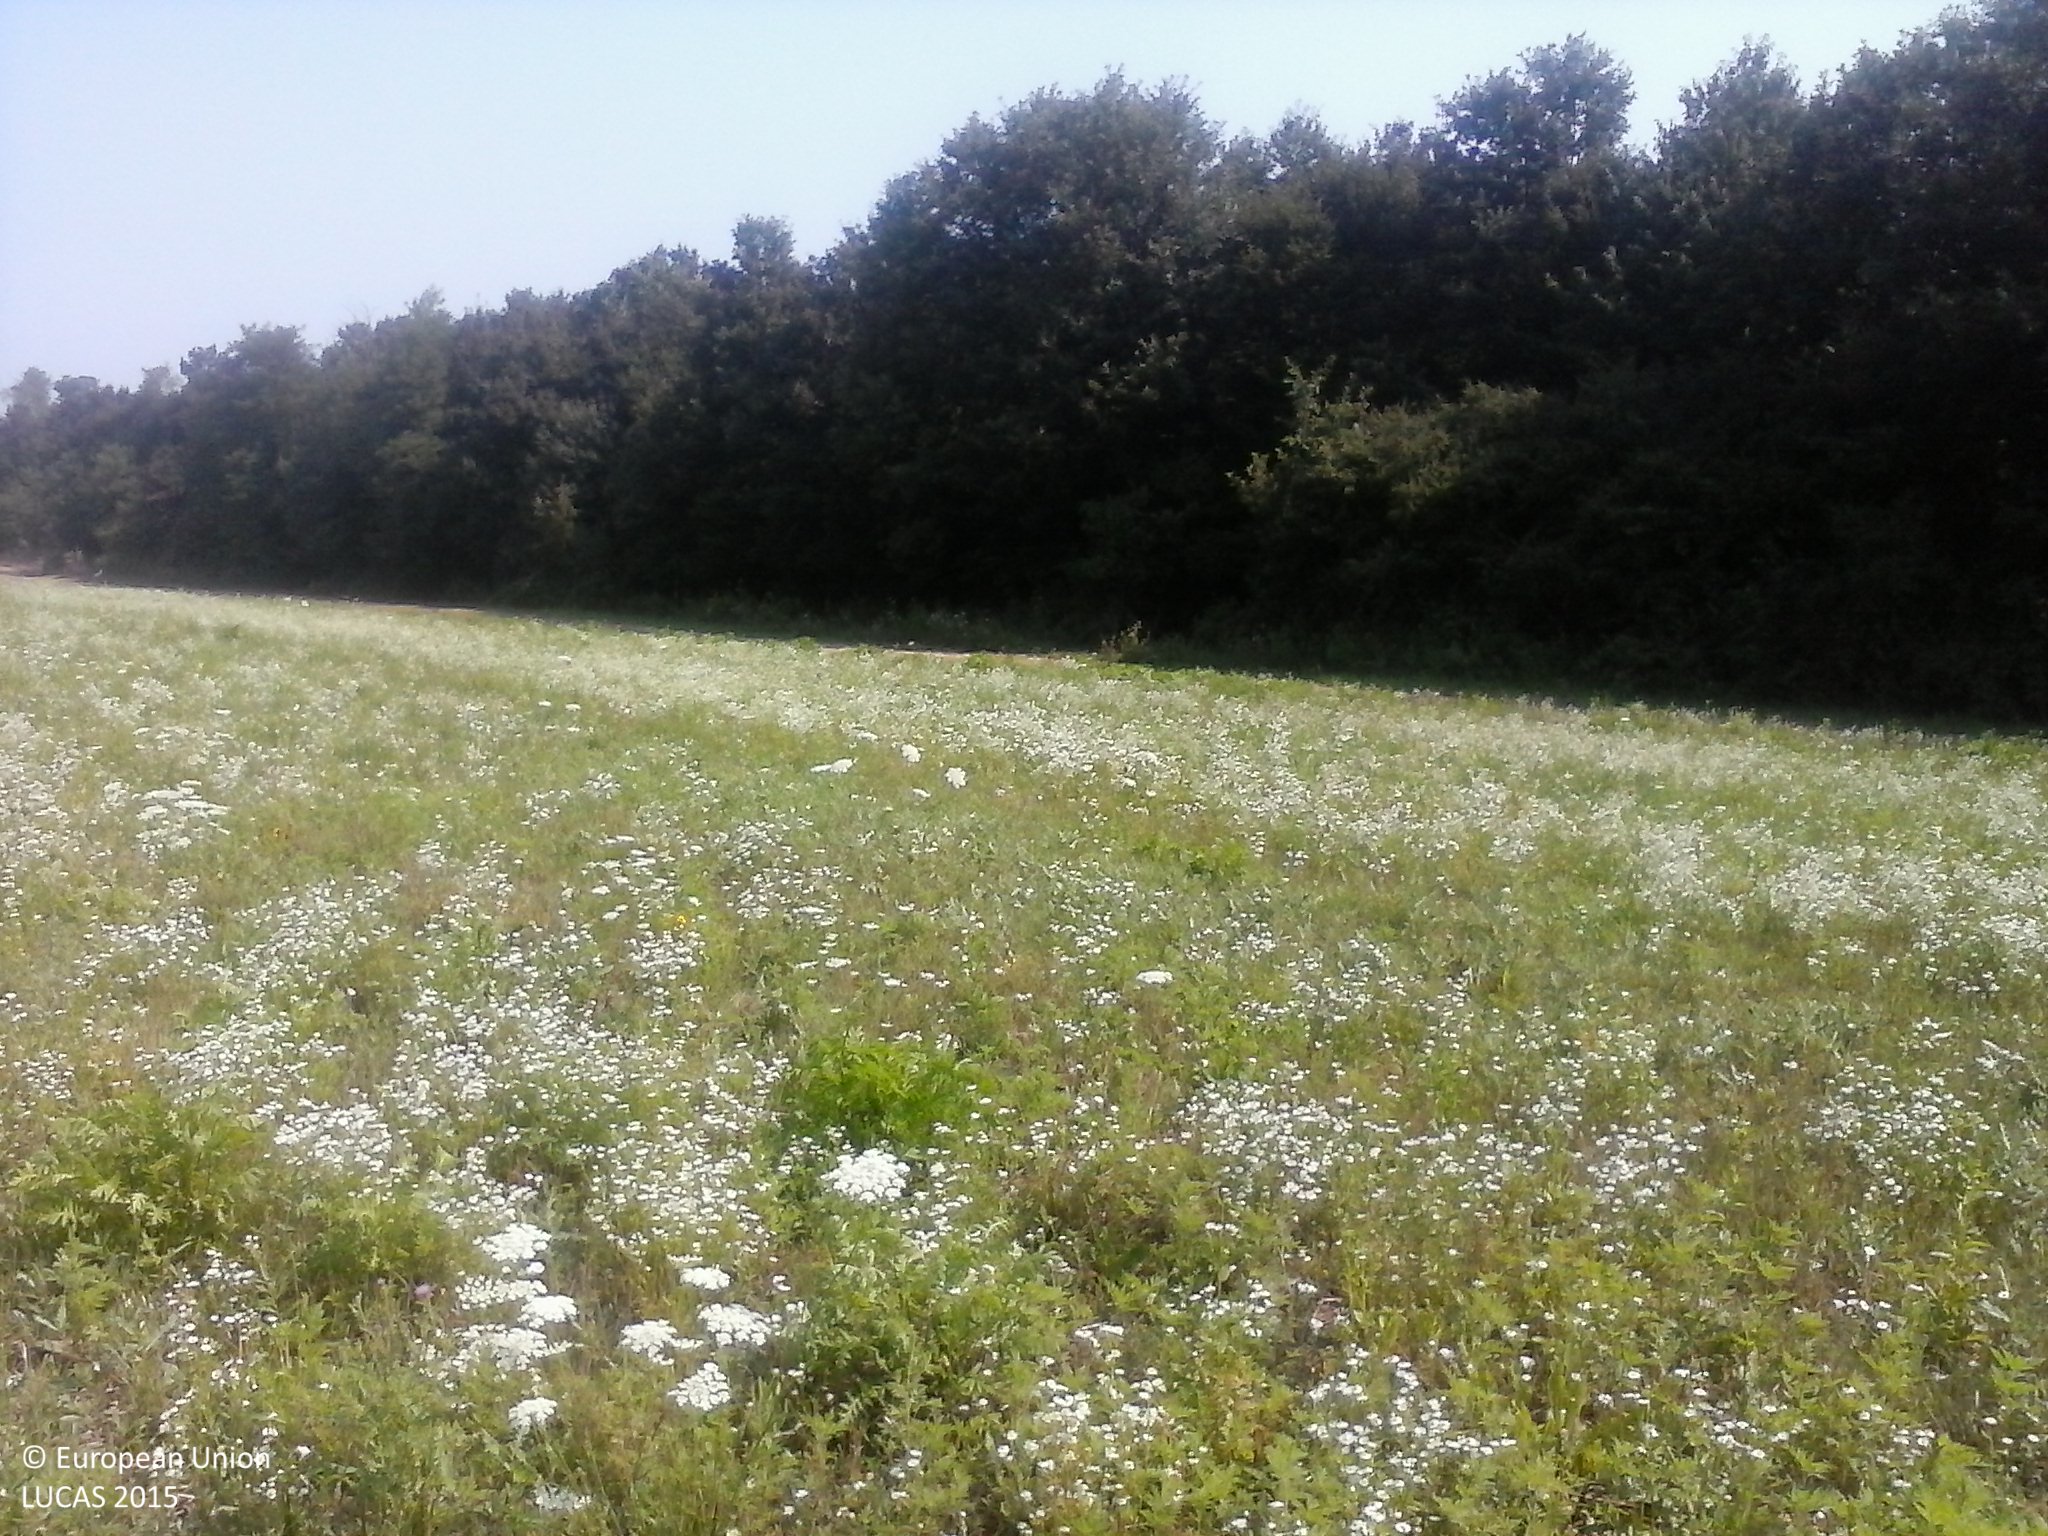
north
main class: Grassland
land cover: Spontaneously vegetated surfaces
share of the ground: > 75 %
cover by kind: herbaceous plants 100 %
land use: Fallow land
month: August
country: HU
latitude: 46.1735
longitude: 17.8160
